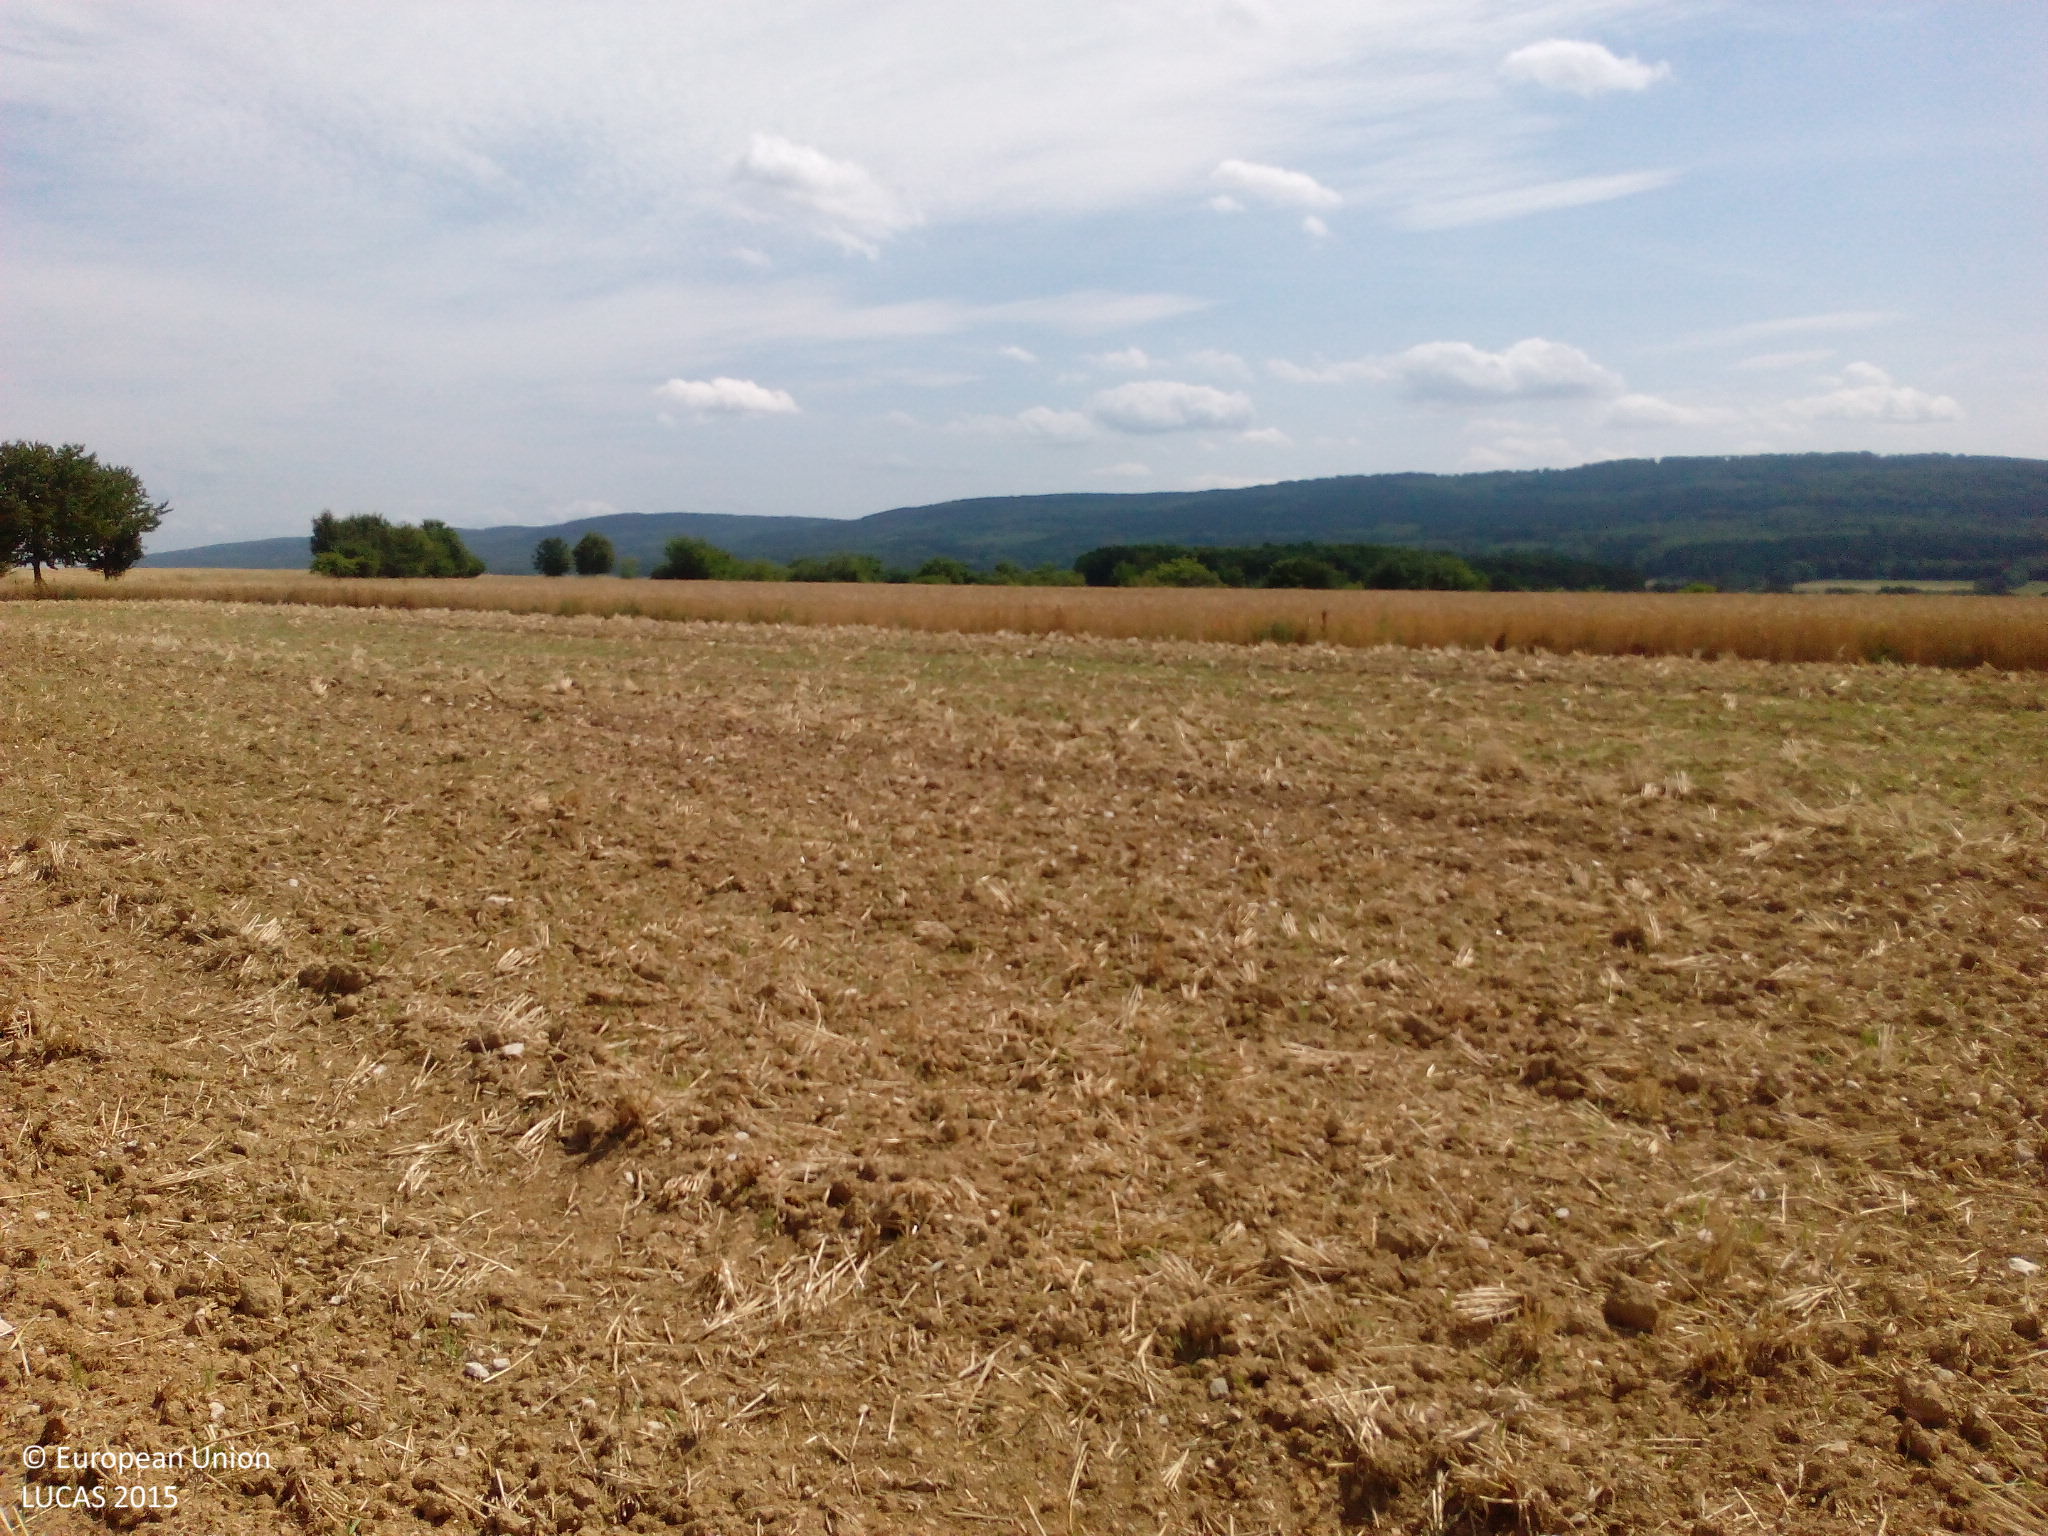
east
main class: Cropland
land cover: Barley
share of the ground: < 10 %
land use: Agriculture (excluding fallow land and kitchen gardens)
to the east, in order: Barley; Common wheat; Grassland without tree/shrub cover; Grassland with sparse tree/shrub cover; Apple fruit; Grass margins; Barley
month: July
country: DE
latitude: 49.9231
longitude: 7.5071
